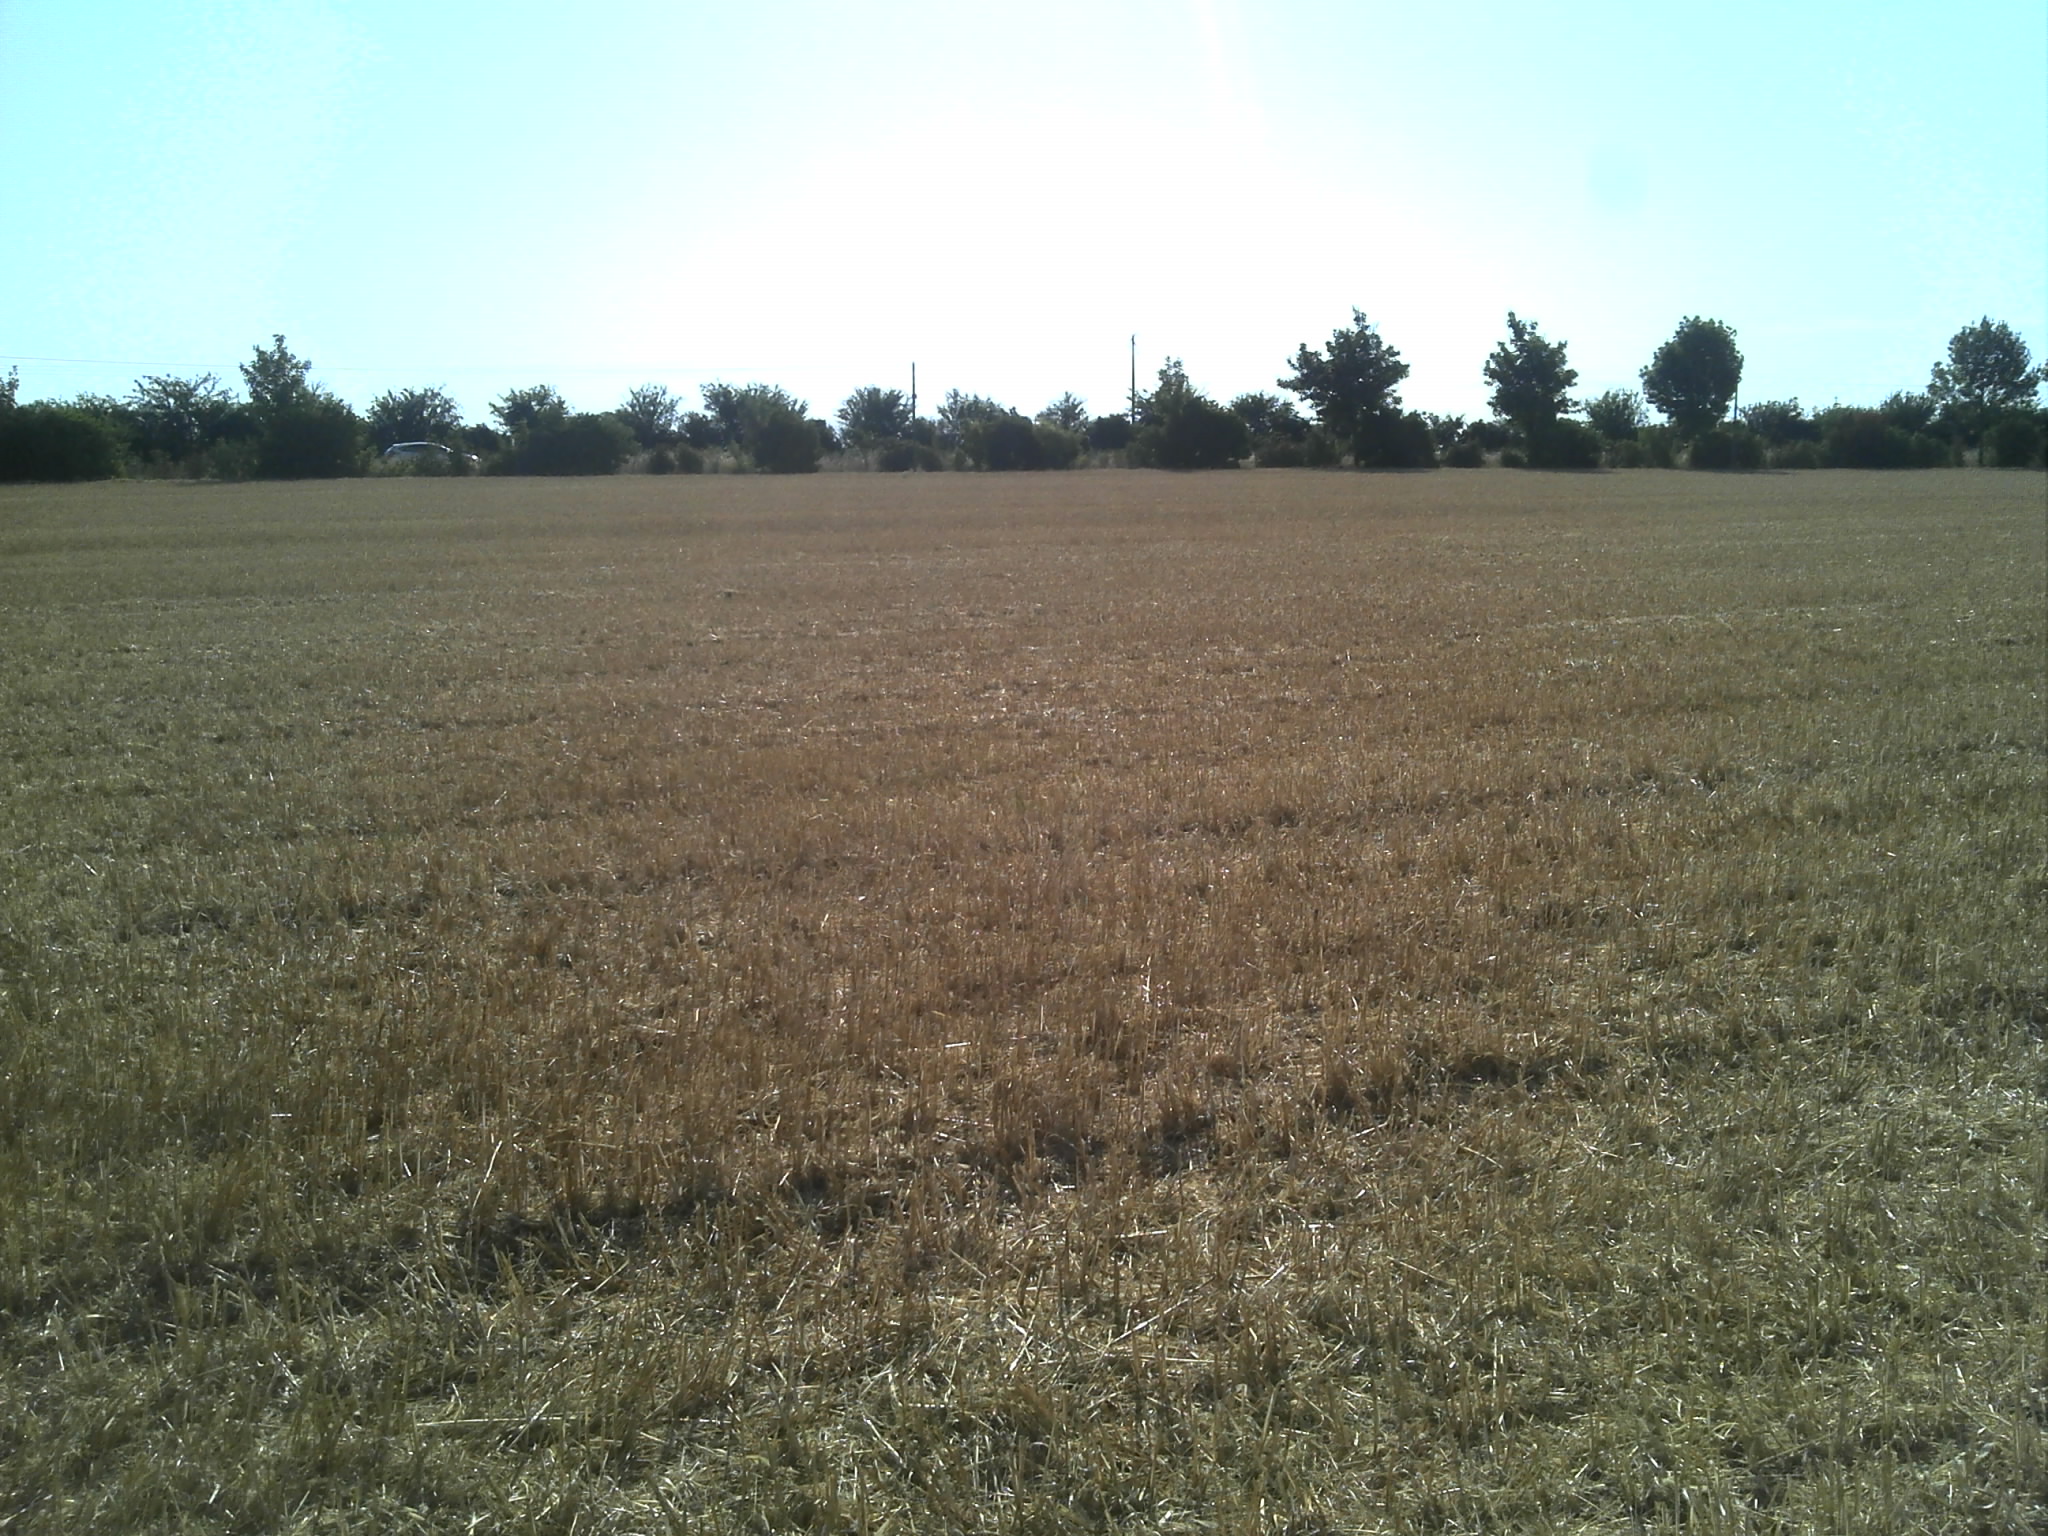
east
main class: Cropland
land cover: Barley
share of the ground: > 75 %
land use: Agriculture (excluding fallow land and kitchen gardens)
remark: Harvested field
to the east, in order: Barley; Electric lines; Lines of trees; Managed hedges; Ditches and canals; Grass margins; Paved roads, cycling and walking lanes; Grass margins; Ditches and canals; Managed hedges; Grass margins; Tracks; Other non-permanent industrial crops; Electric lines; Sunflower
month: July
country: FR
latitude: 46.9630
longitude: 1.6172
